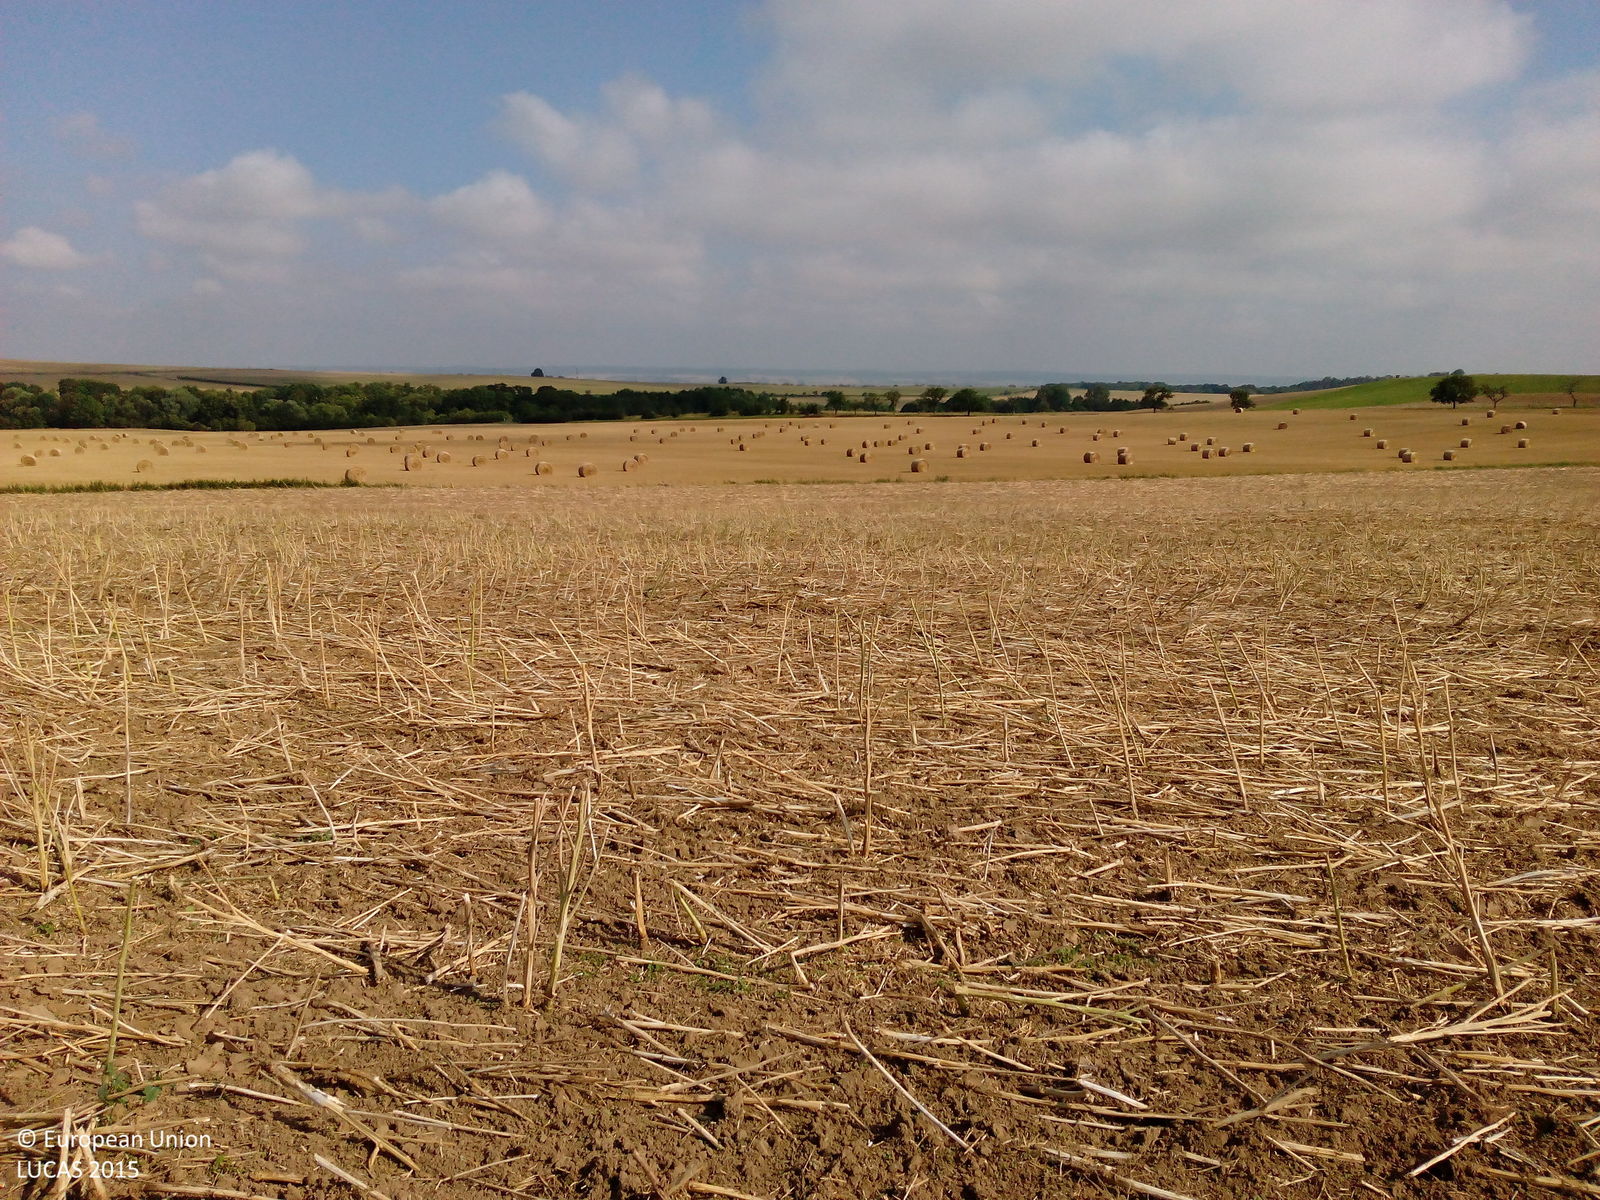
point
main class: Cropland
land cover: Rape and turnip rape
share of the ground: 10 - 25 %
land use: Agriculture (excluding fallow land and kitchen gardens)
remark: Harvested field
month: August
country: DE
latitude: 51.8342
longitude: 10.9720
